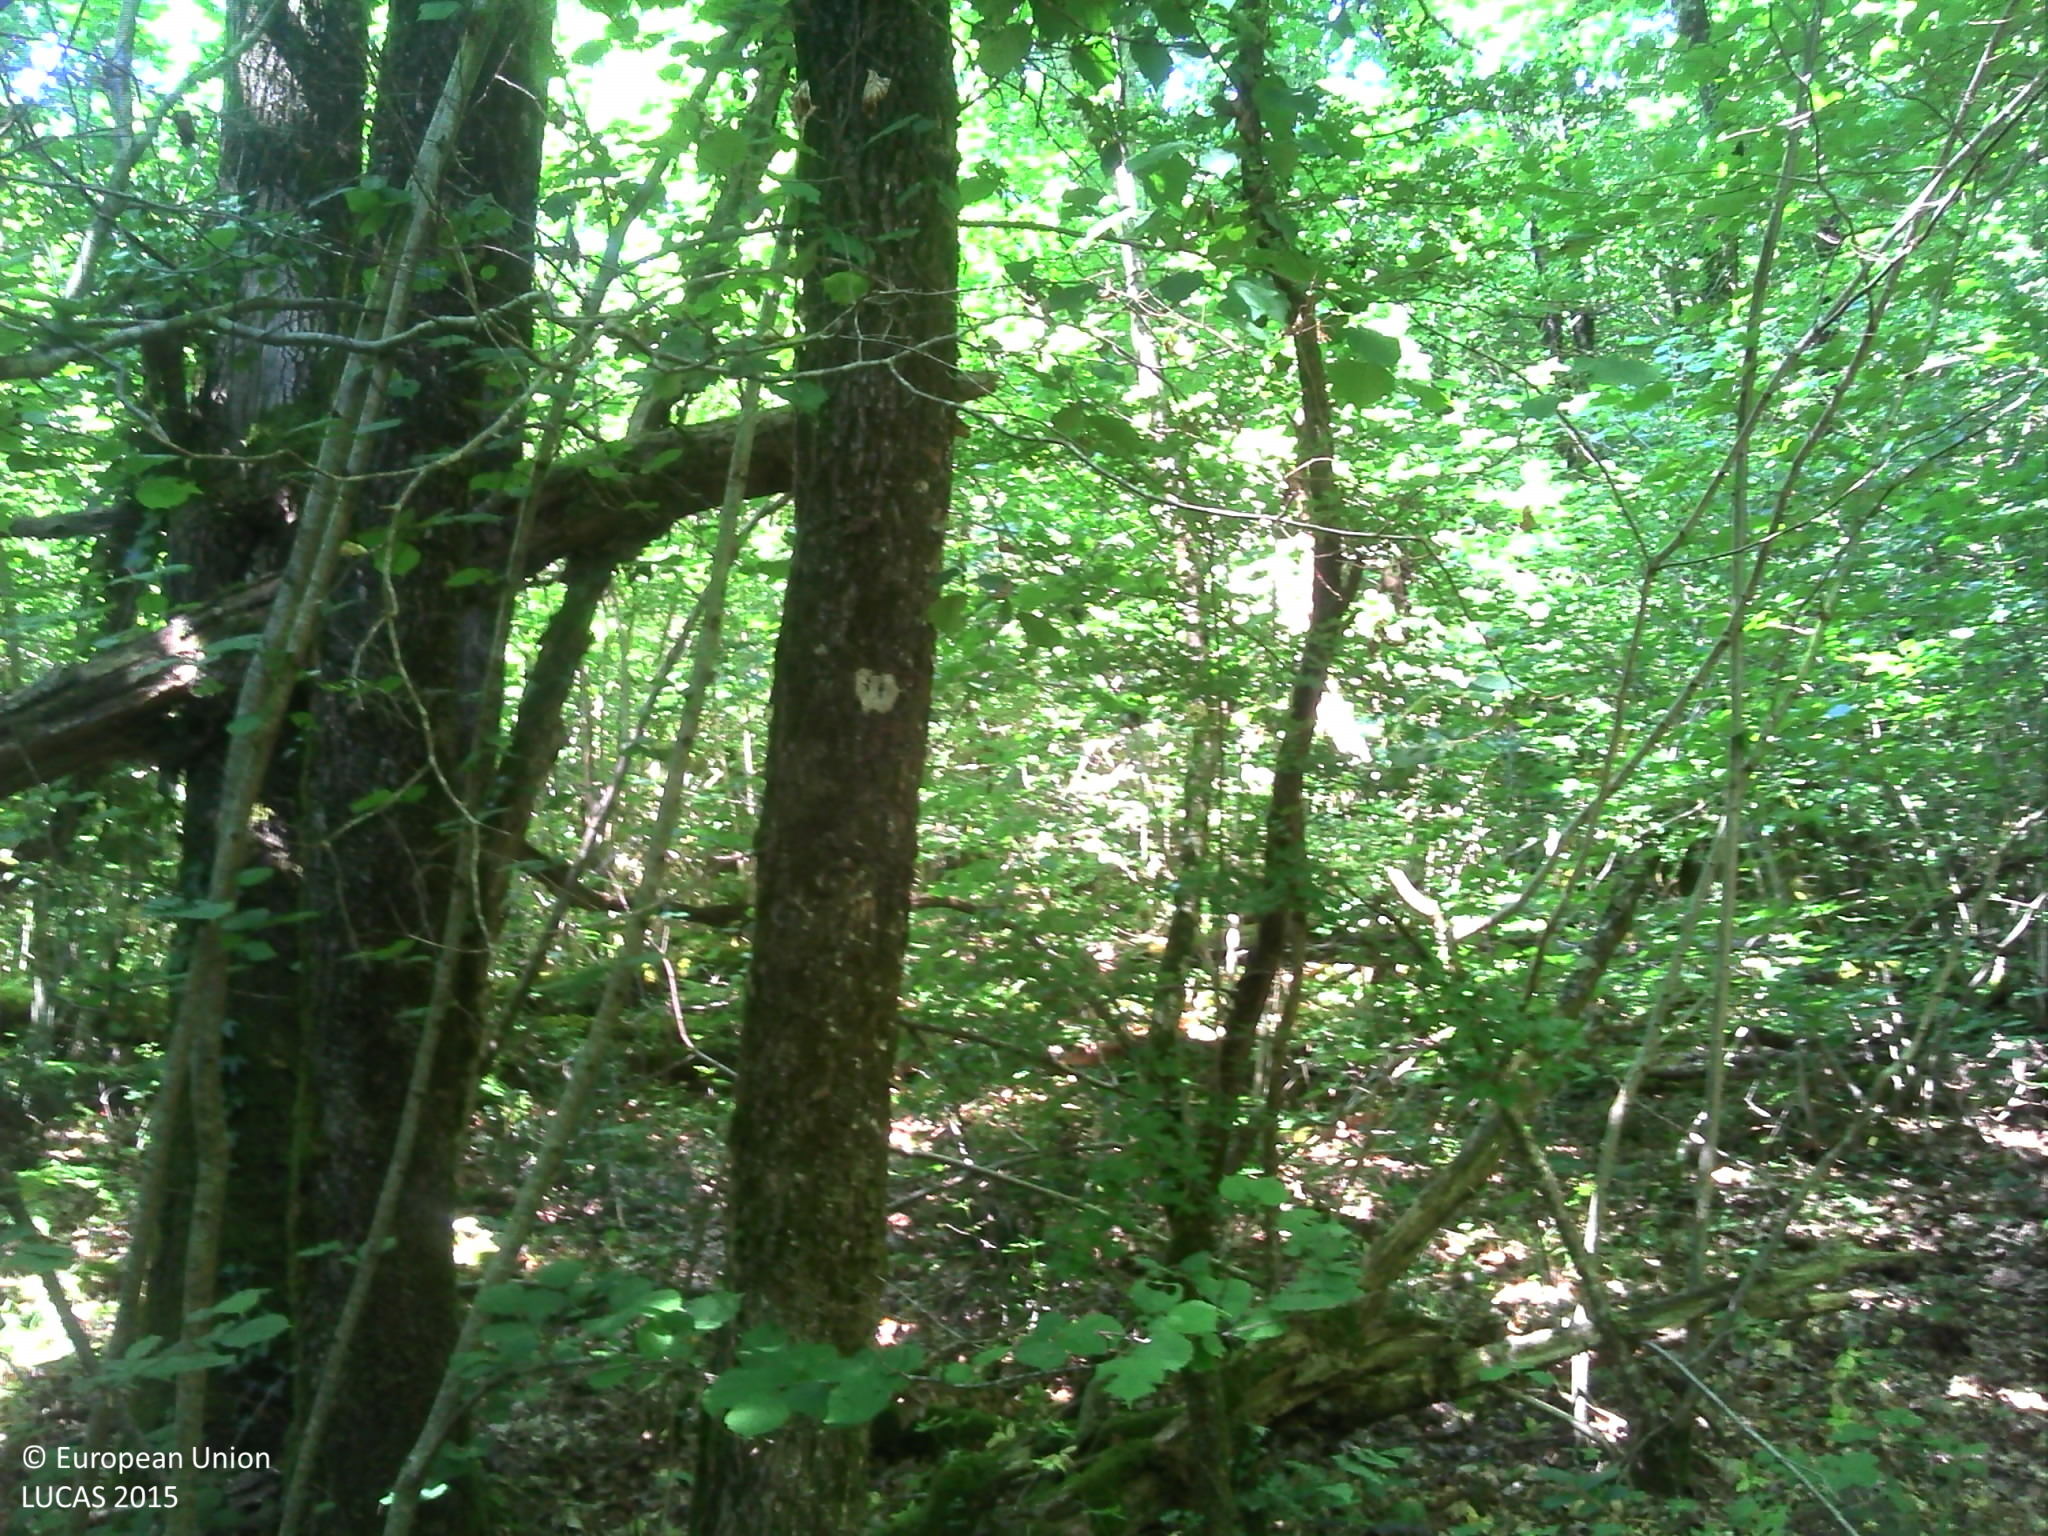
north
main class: Woodland
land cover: Broadleaved woodland
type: mesophytic deciduous forest
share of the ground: > 75 %
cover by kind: broadleaved forest trees 100 %
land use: Forestry
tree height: > 5 m
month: June
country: FR
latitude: 45.6558
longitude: -0.6367
